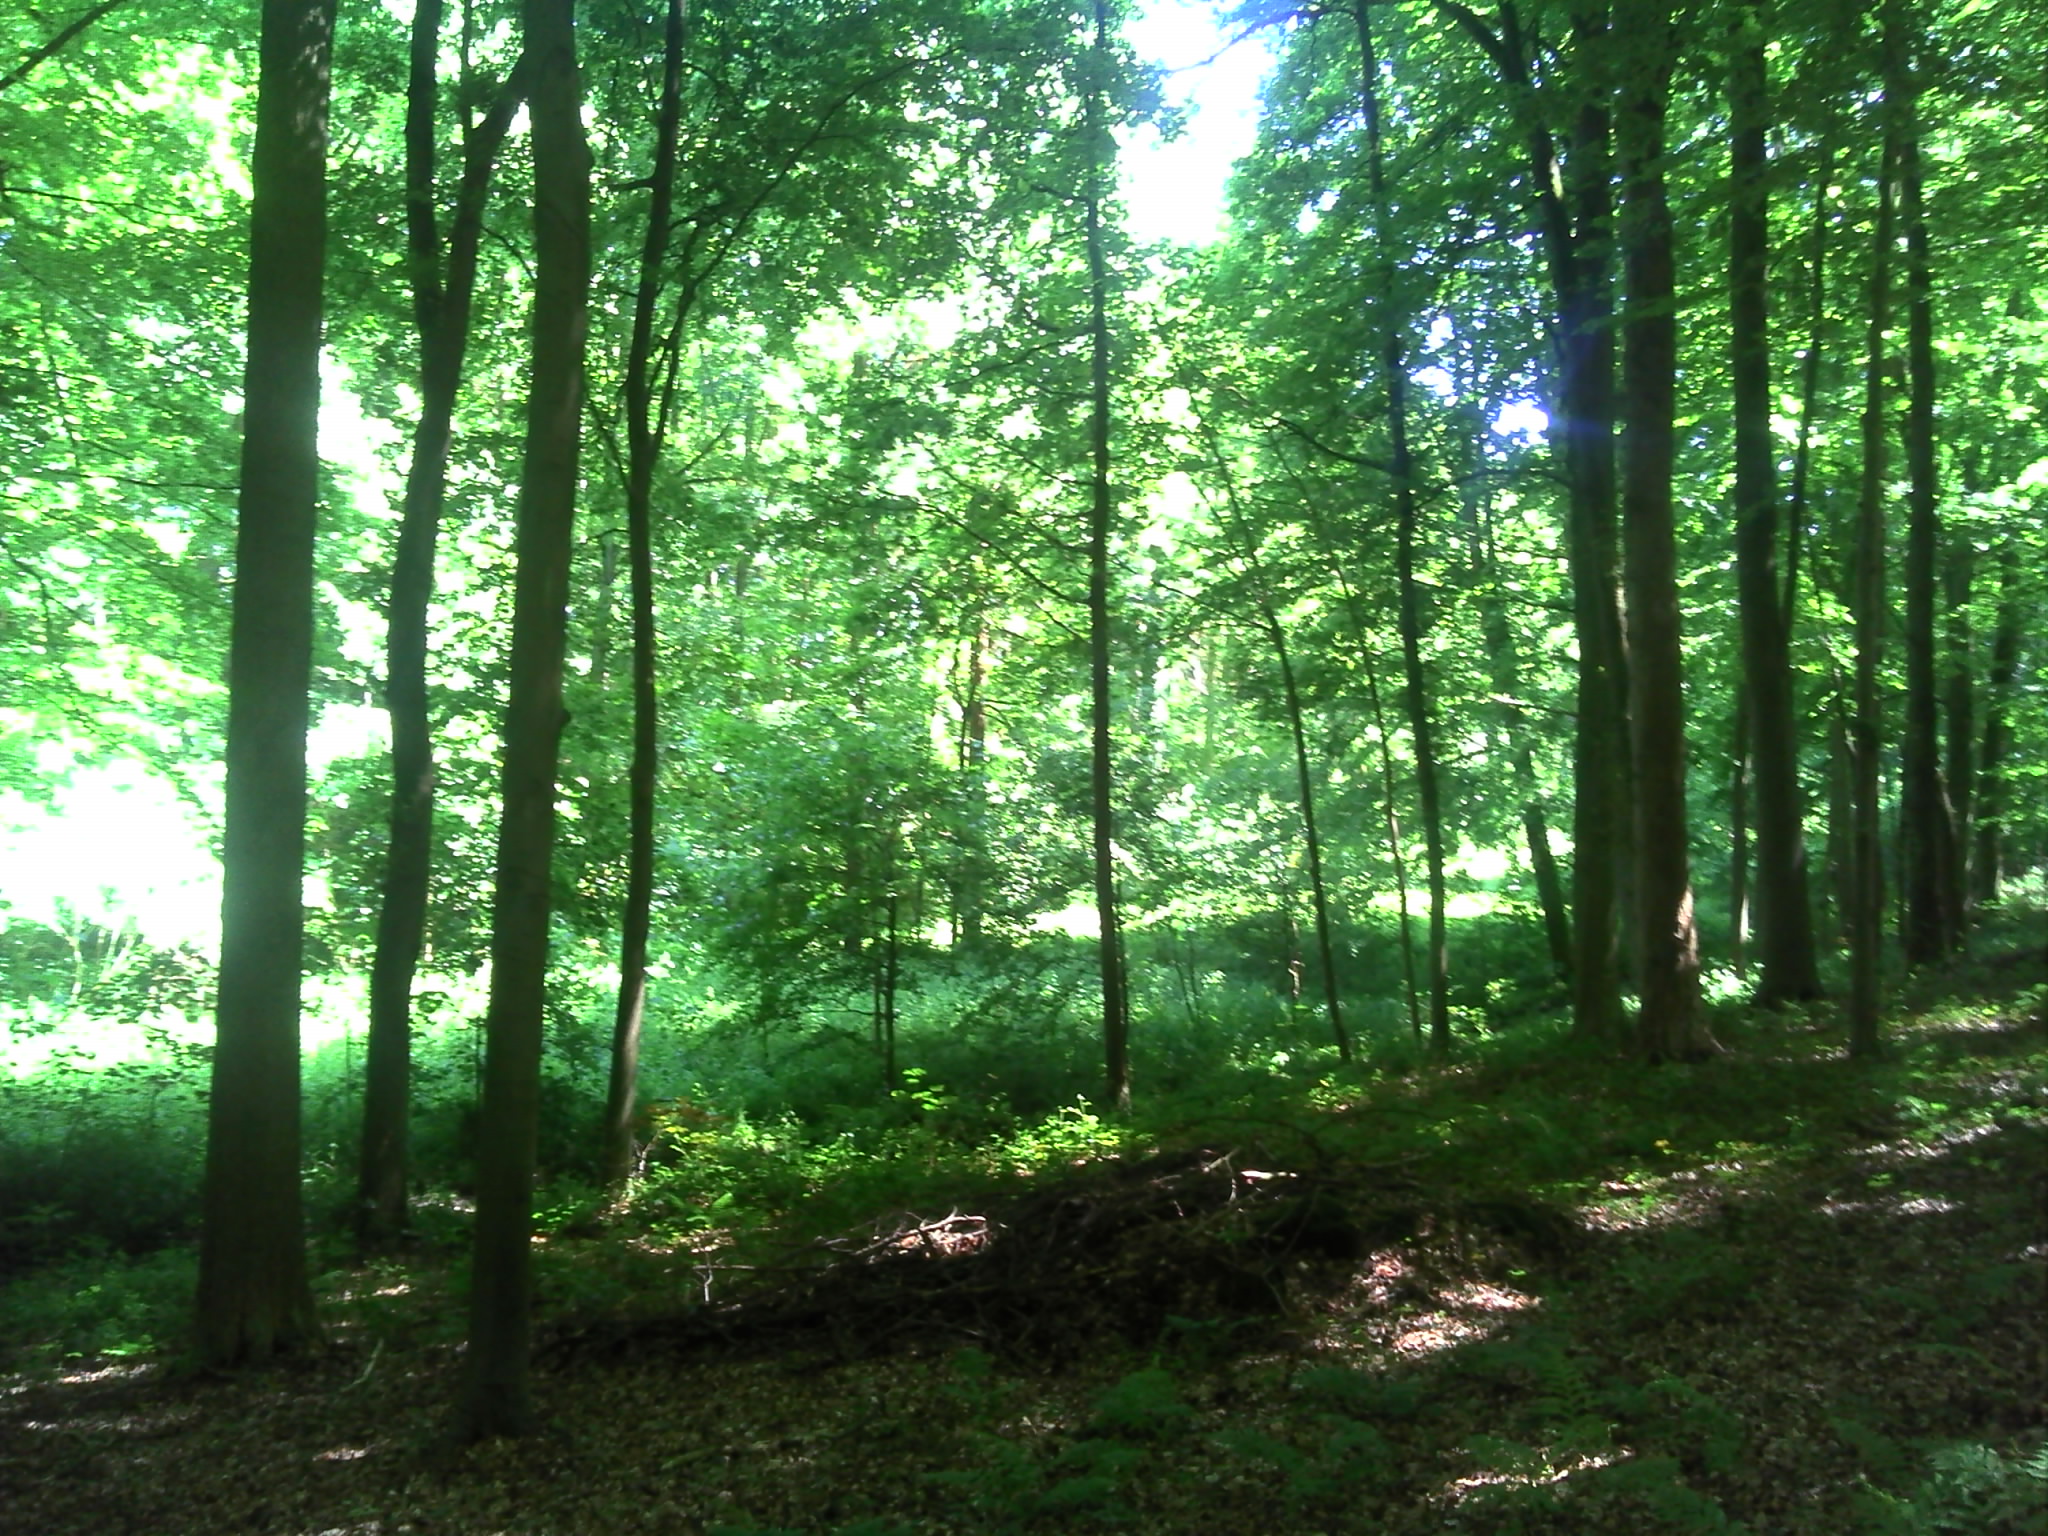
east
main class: Woodland
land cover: Broadleaved woodland
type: acidophilous oak and oak-birch forest
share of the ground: > 75 %
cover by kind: broadleaved forest trees 80 %, herbaceous plants 10 %, coniferous forest trees 5 %, shrubs 5 %
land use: Forestry
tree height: > 5 m
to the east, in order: Broadleaved woodland; Tracks; Broadleaved woodland; Tracks; Broadleaved woodland; Grassland without tree/shrub cover; Broadleaved woodland; Fences; Grassland without tree/shrub cover; Fences; Managed hedges; Grassland without tree/shrub cover
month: June
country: BE
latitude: 50.7370
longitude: 4.5122
